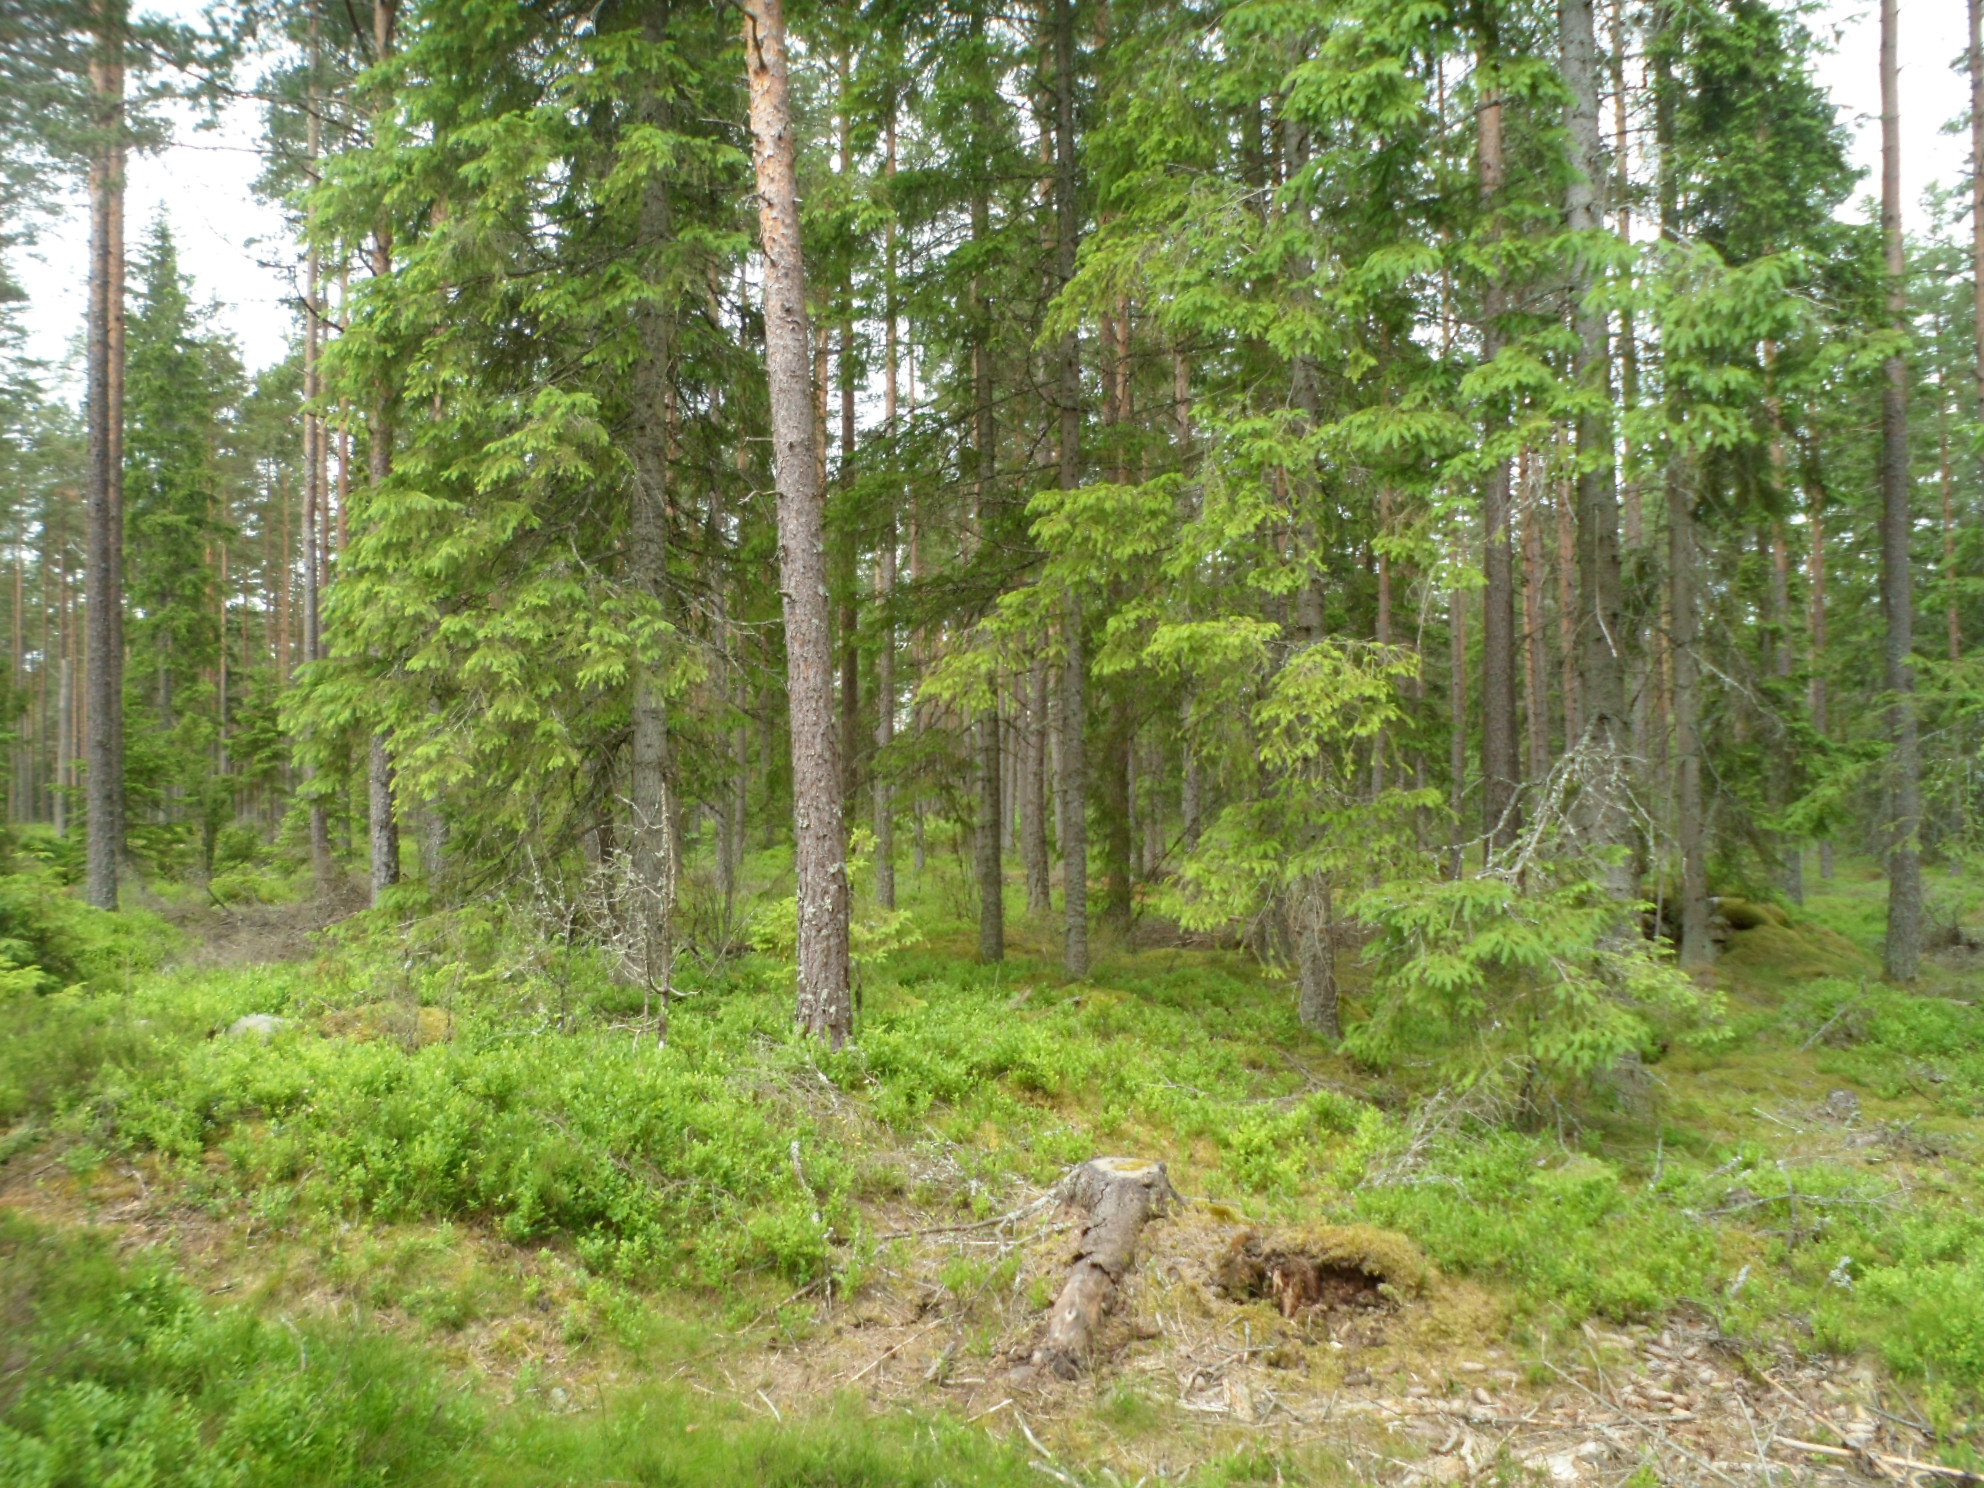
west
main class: Woodland
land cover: Pine dominated coniferous woodland
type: boreal forest
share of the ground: 50 - 75 %
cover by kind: coniferous forest trees 50 %, shrubs 20 %, lichens and mosses 20 %, herbaceous plants 10 %
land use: Forestry
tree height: > 5 m
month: June
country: SE
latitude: 56.9623
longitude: 15.2768
